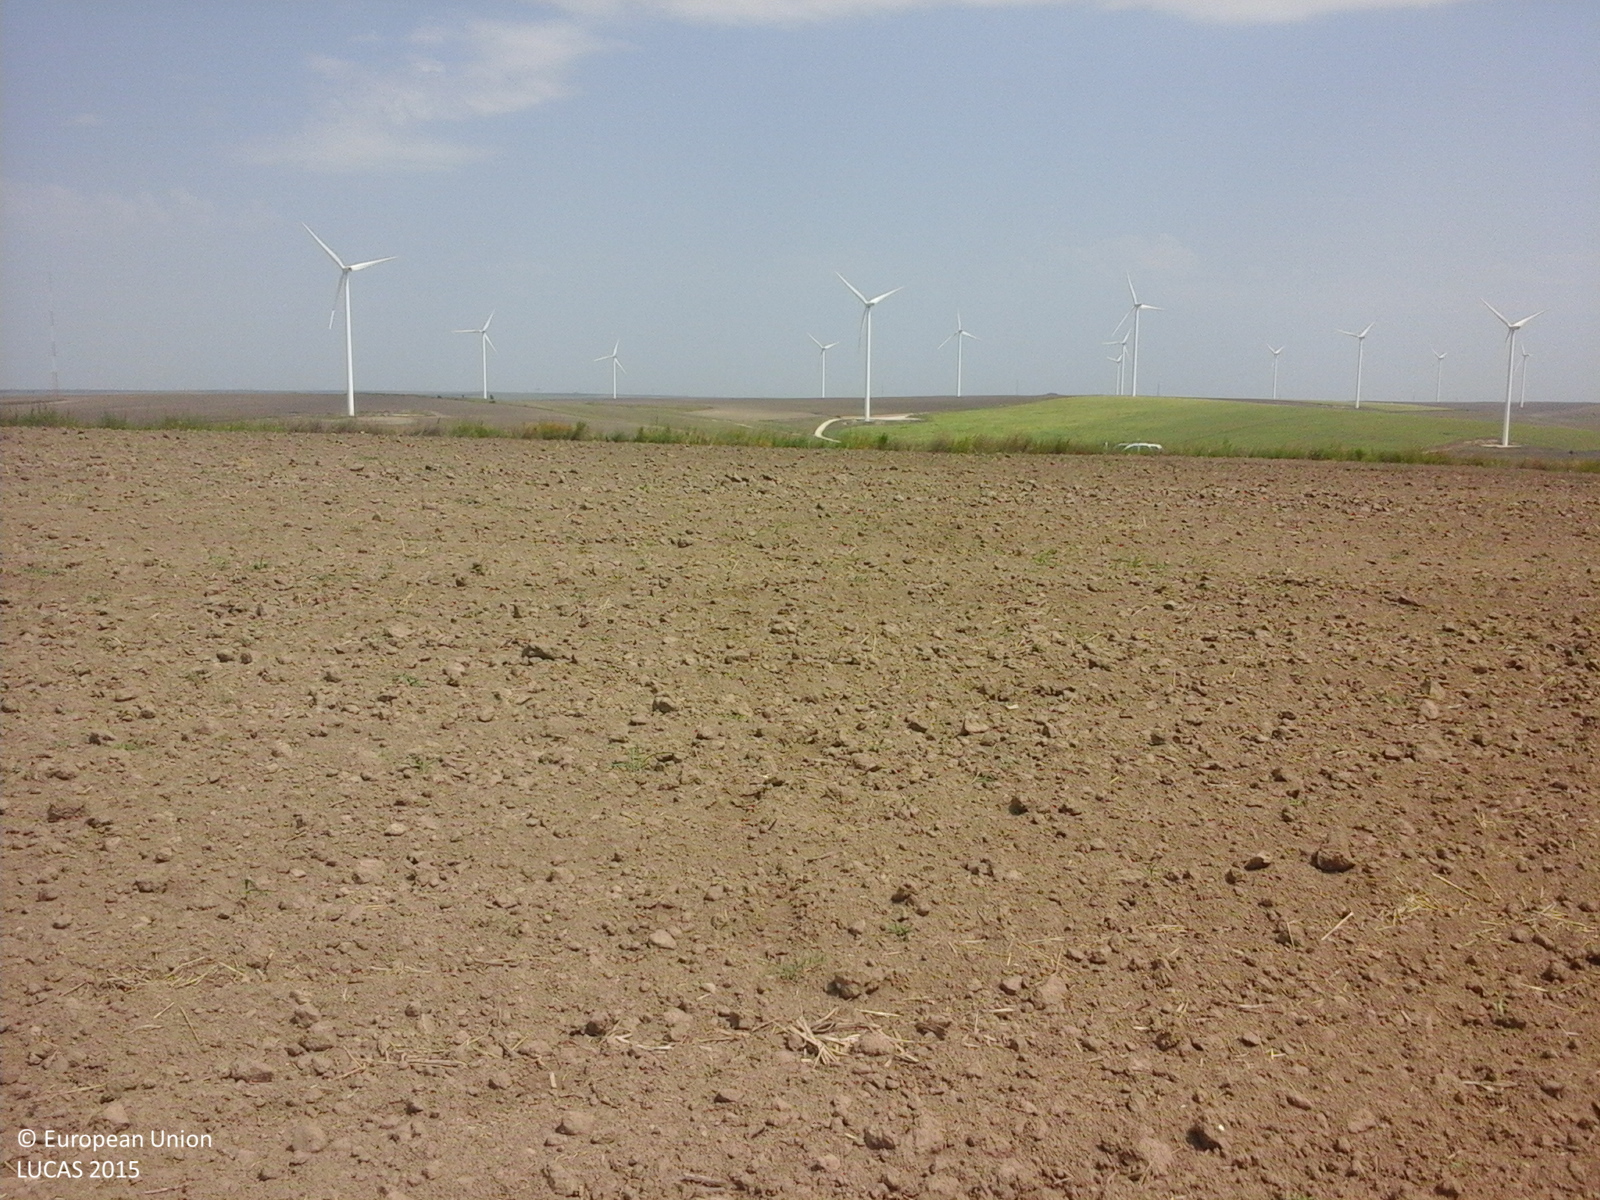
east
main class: Cropland
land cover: Common wheat
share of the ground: < 10 %
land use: Agriculture (excluding fallow land and kitchen gardens)
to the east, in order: Common wheat; Shruby margins; Ditches and canals; Tracks; Ditches and canals; Shruby margins; Other bare soil
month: August
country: RO
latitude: 44.2149
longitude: 28.0155
